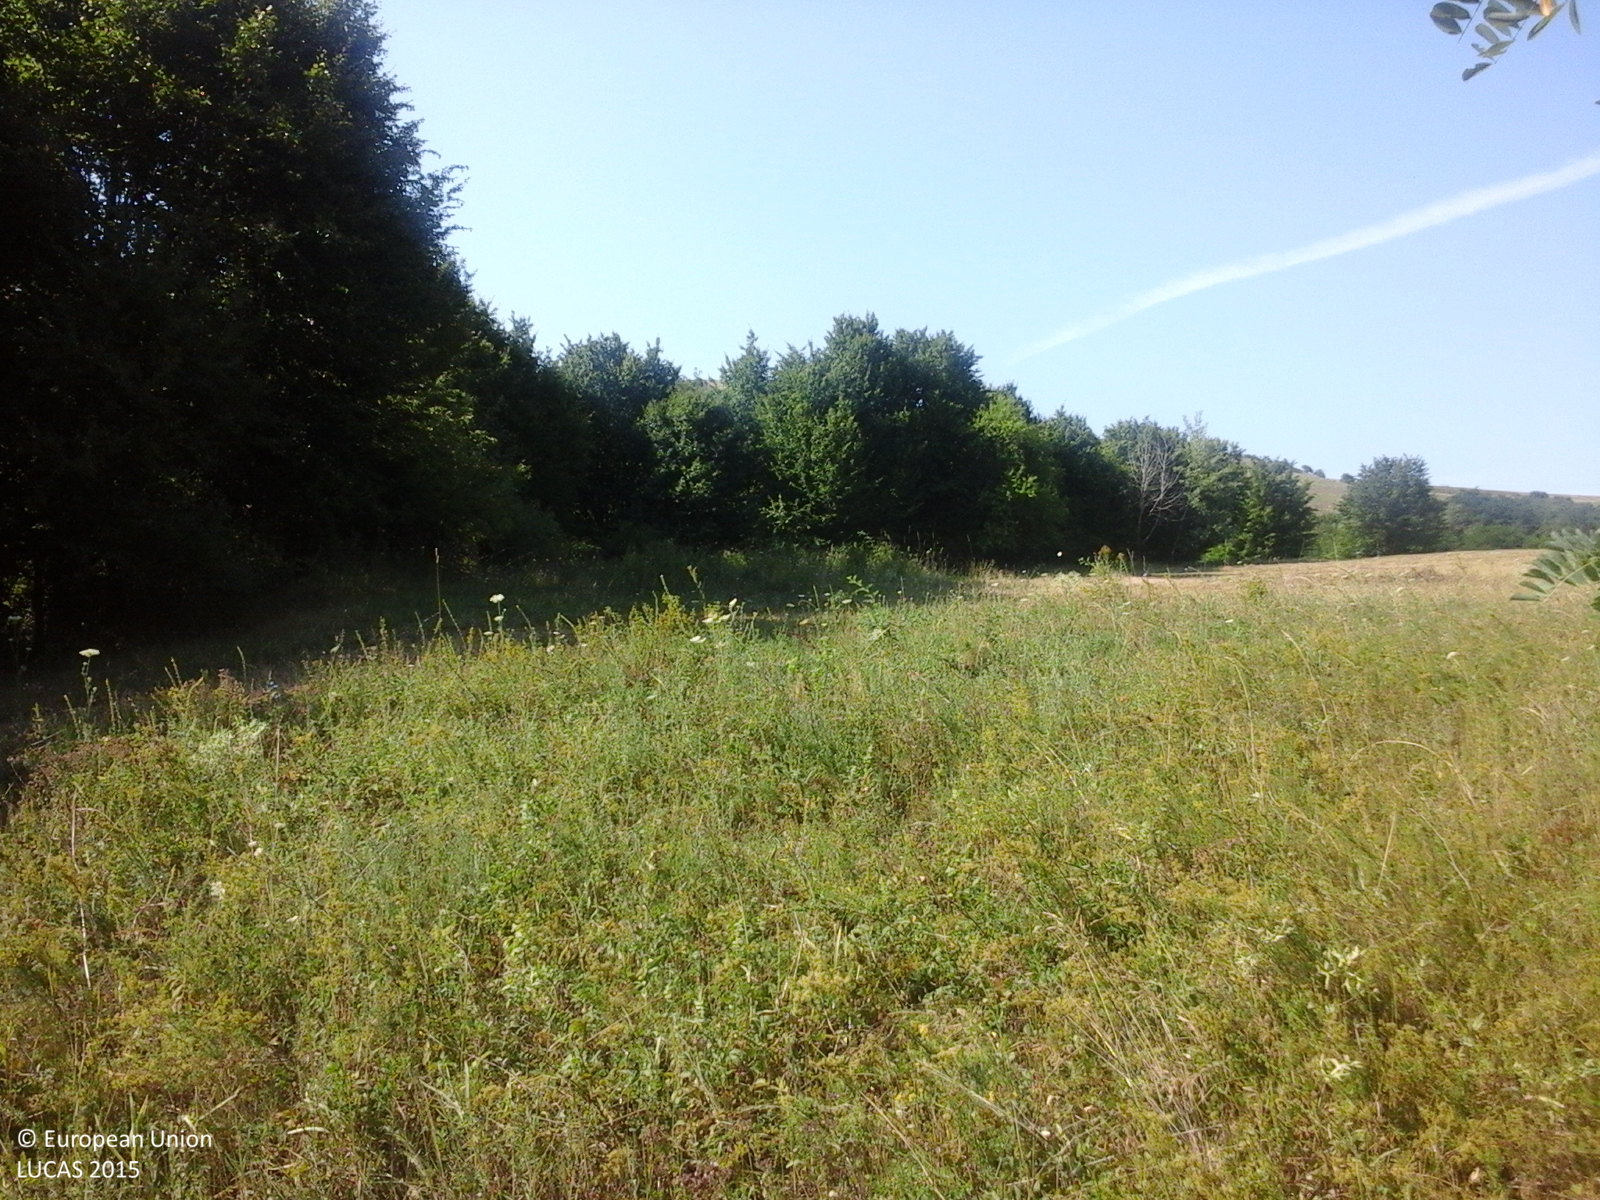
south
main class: Grassland
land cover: Grassland without tree/shrub cover
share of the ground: > 75 %
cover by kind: herbaceous plants 100 %
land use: Agriculture (excluding fallow land and kitchen gardens)
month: July
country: RO
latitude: 46.5495
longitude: 27.1734
